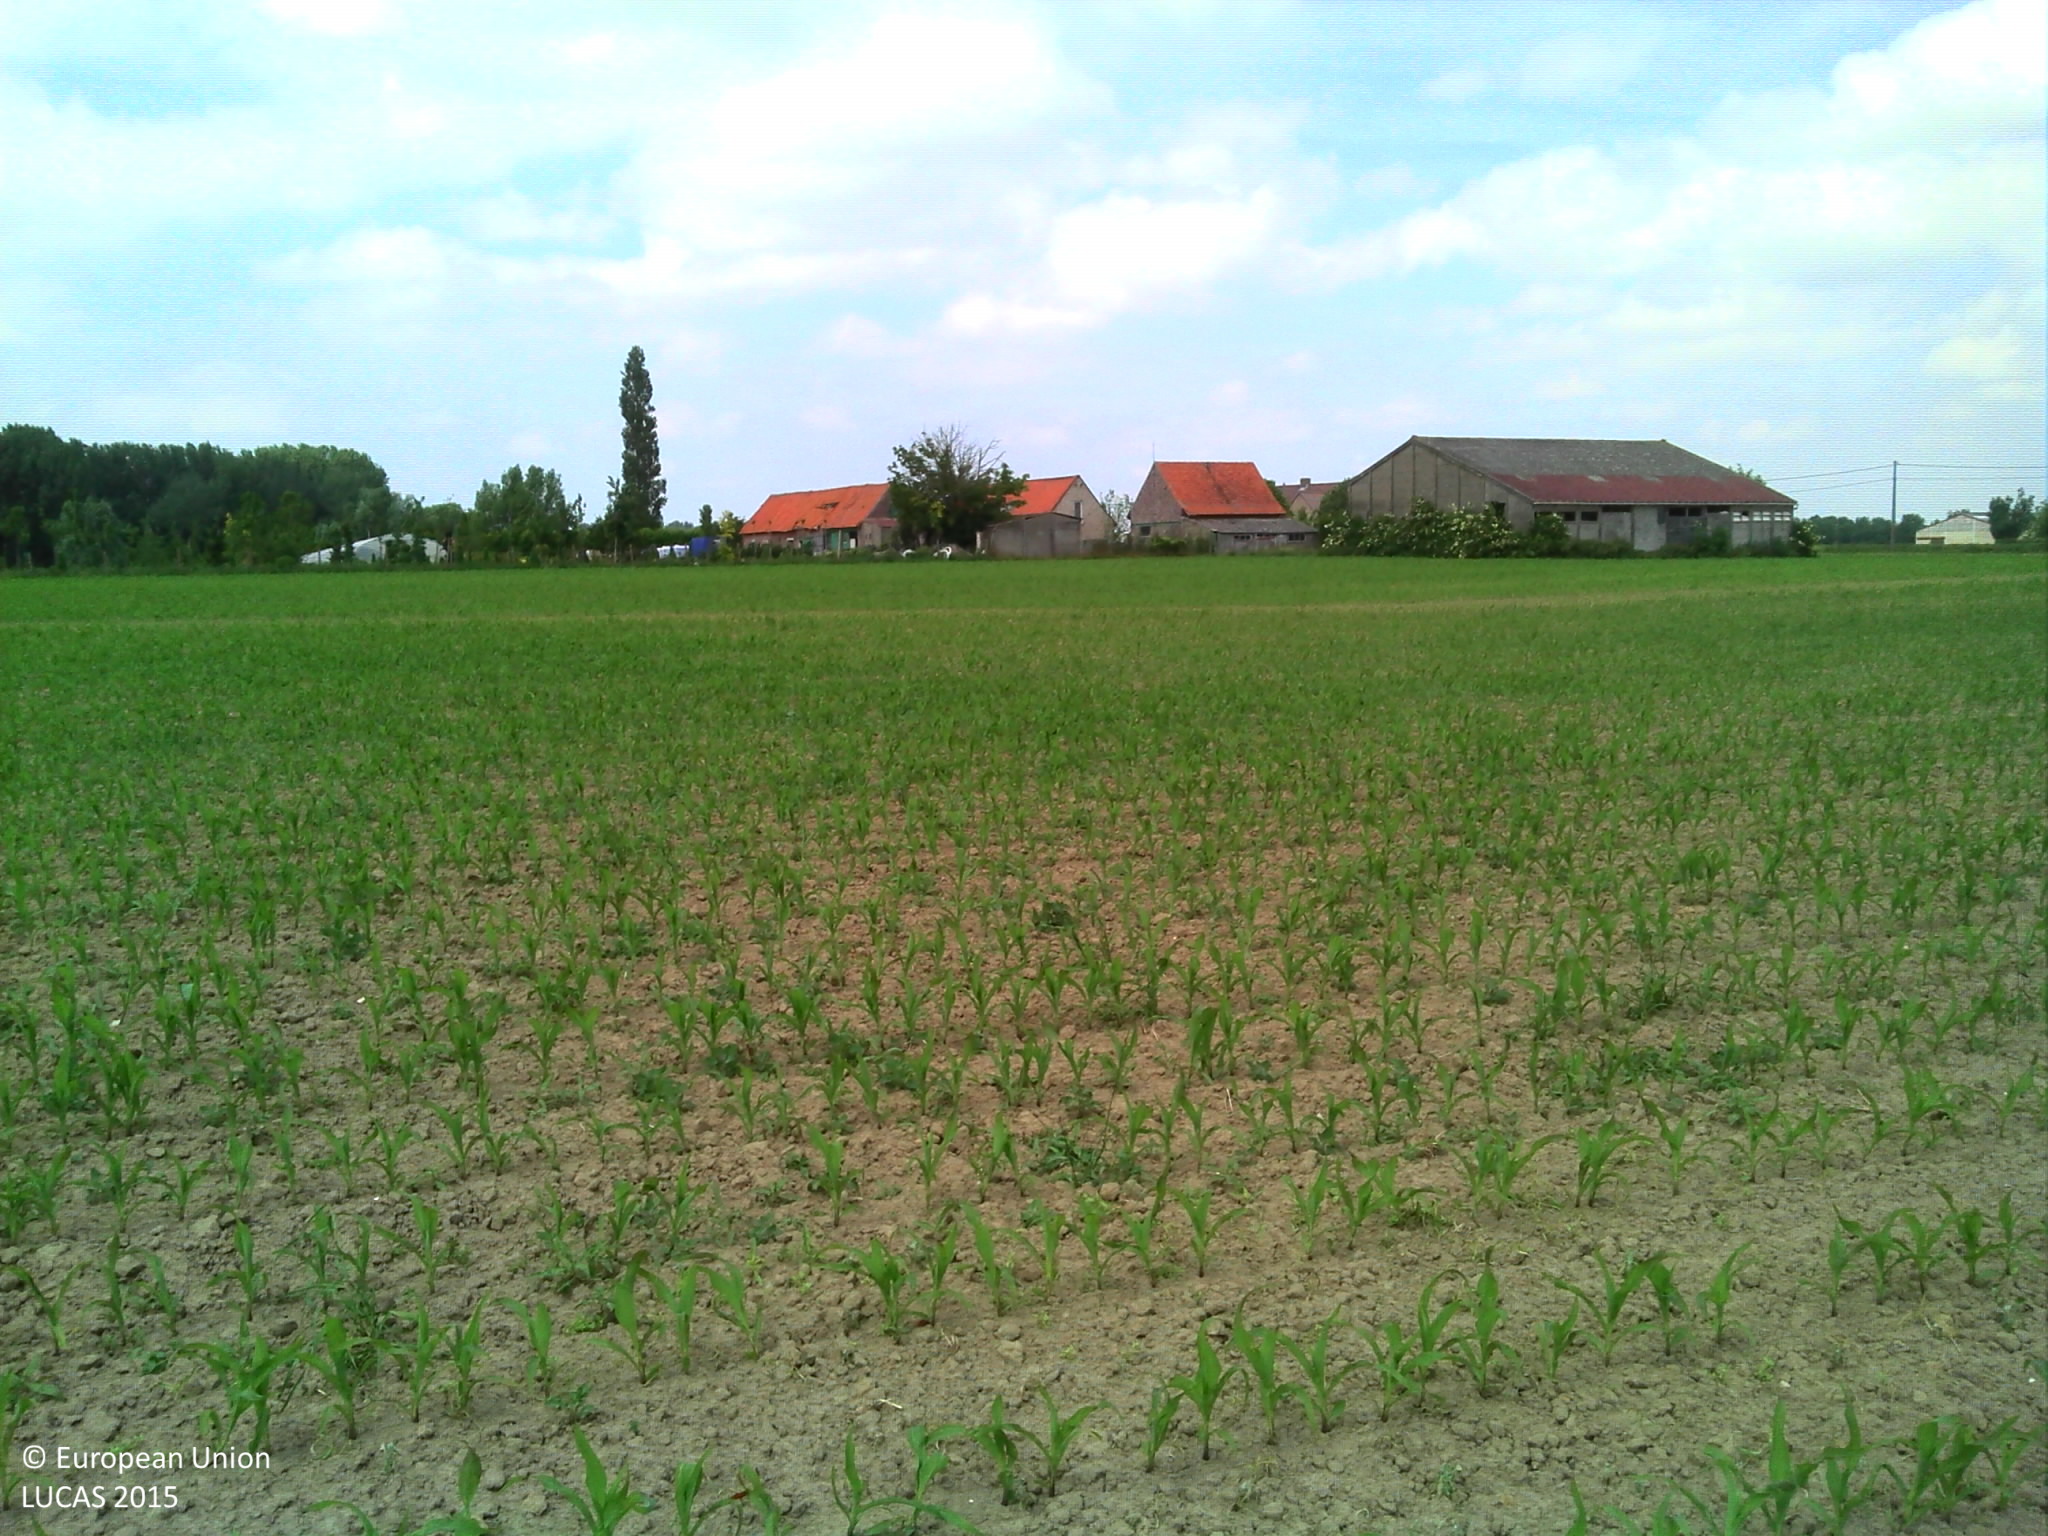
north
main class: Cropland
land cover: Maize
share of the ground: 10 - 25 %
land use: Agriculture (excluding fallow land and kitchen gardens)
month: June
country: BE
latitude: 50.8422
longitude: 2.8172
